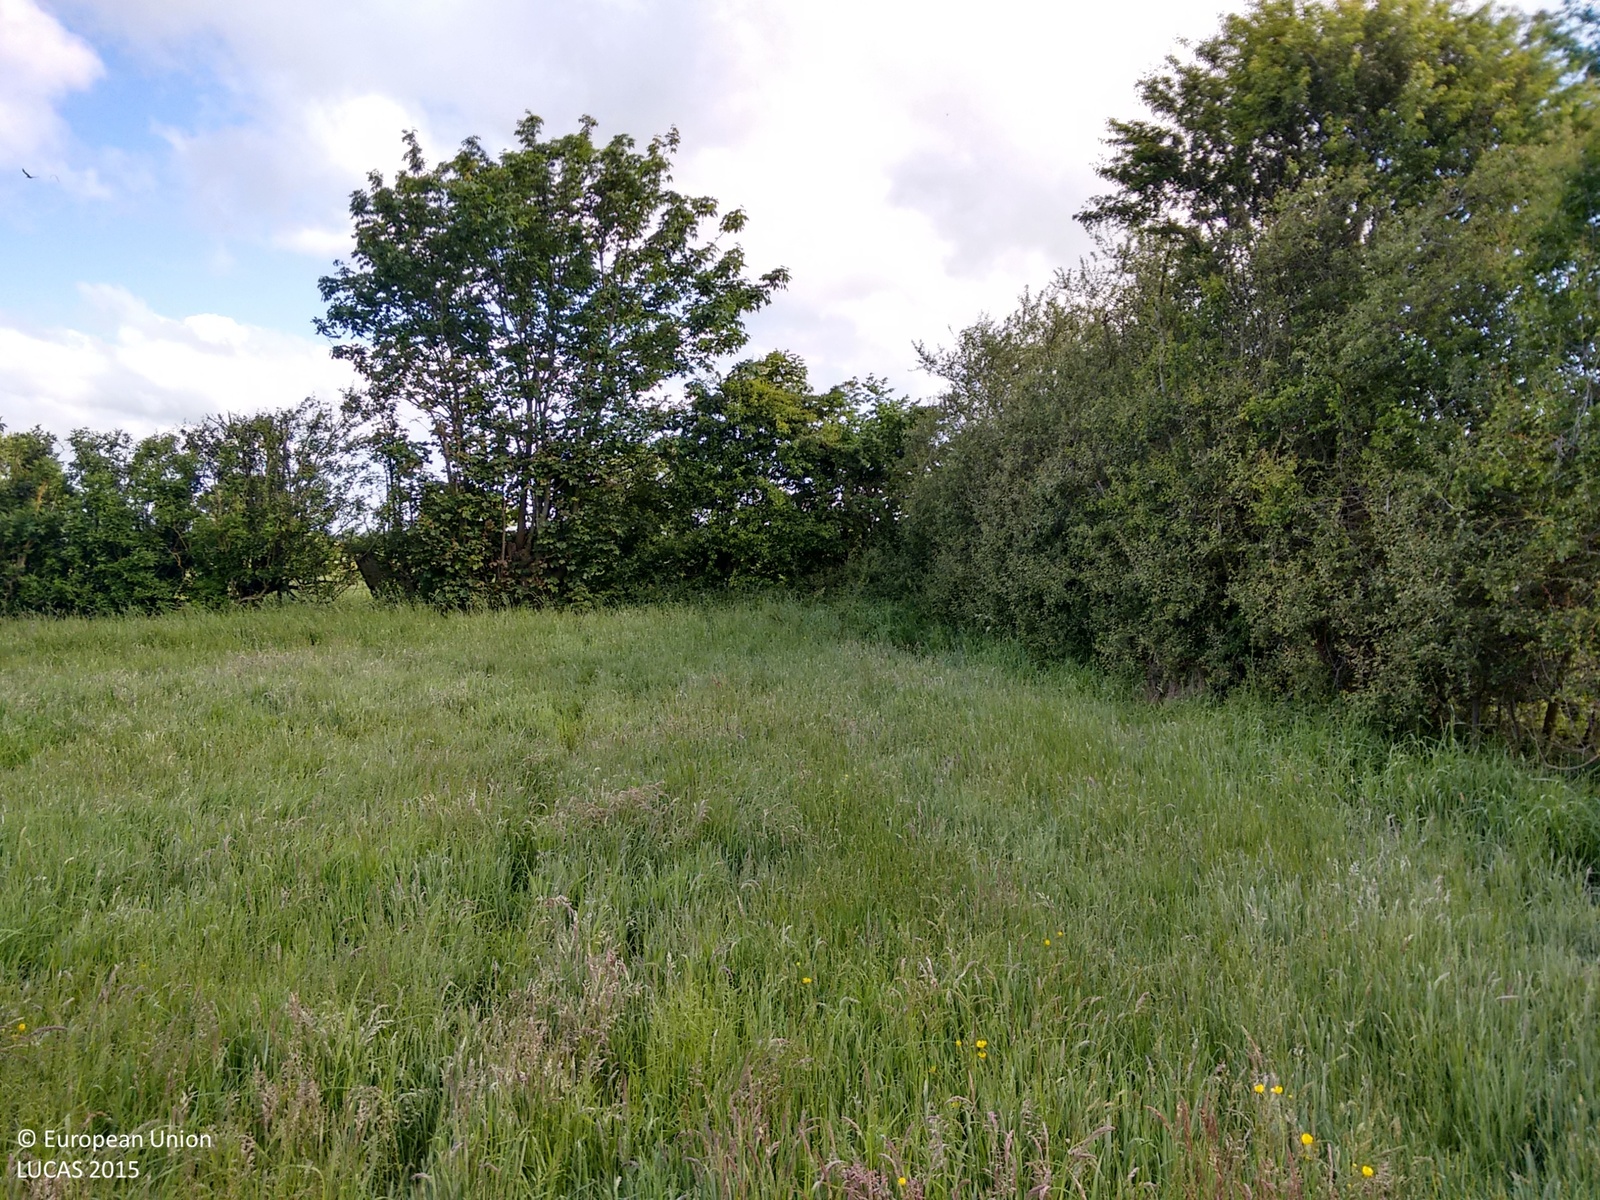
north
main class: Grassland
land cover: Grassland without tree/shrub cover
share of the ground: > 75 %
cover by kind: herbaceous plants 100 %
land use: Agriculture (excluding fallow land and kitchen gardens)
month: June
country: GB
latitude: 54.0802
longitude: -1.1878
